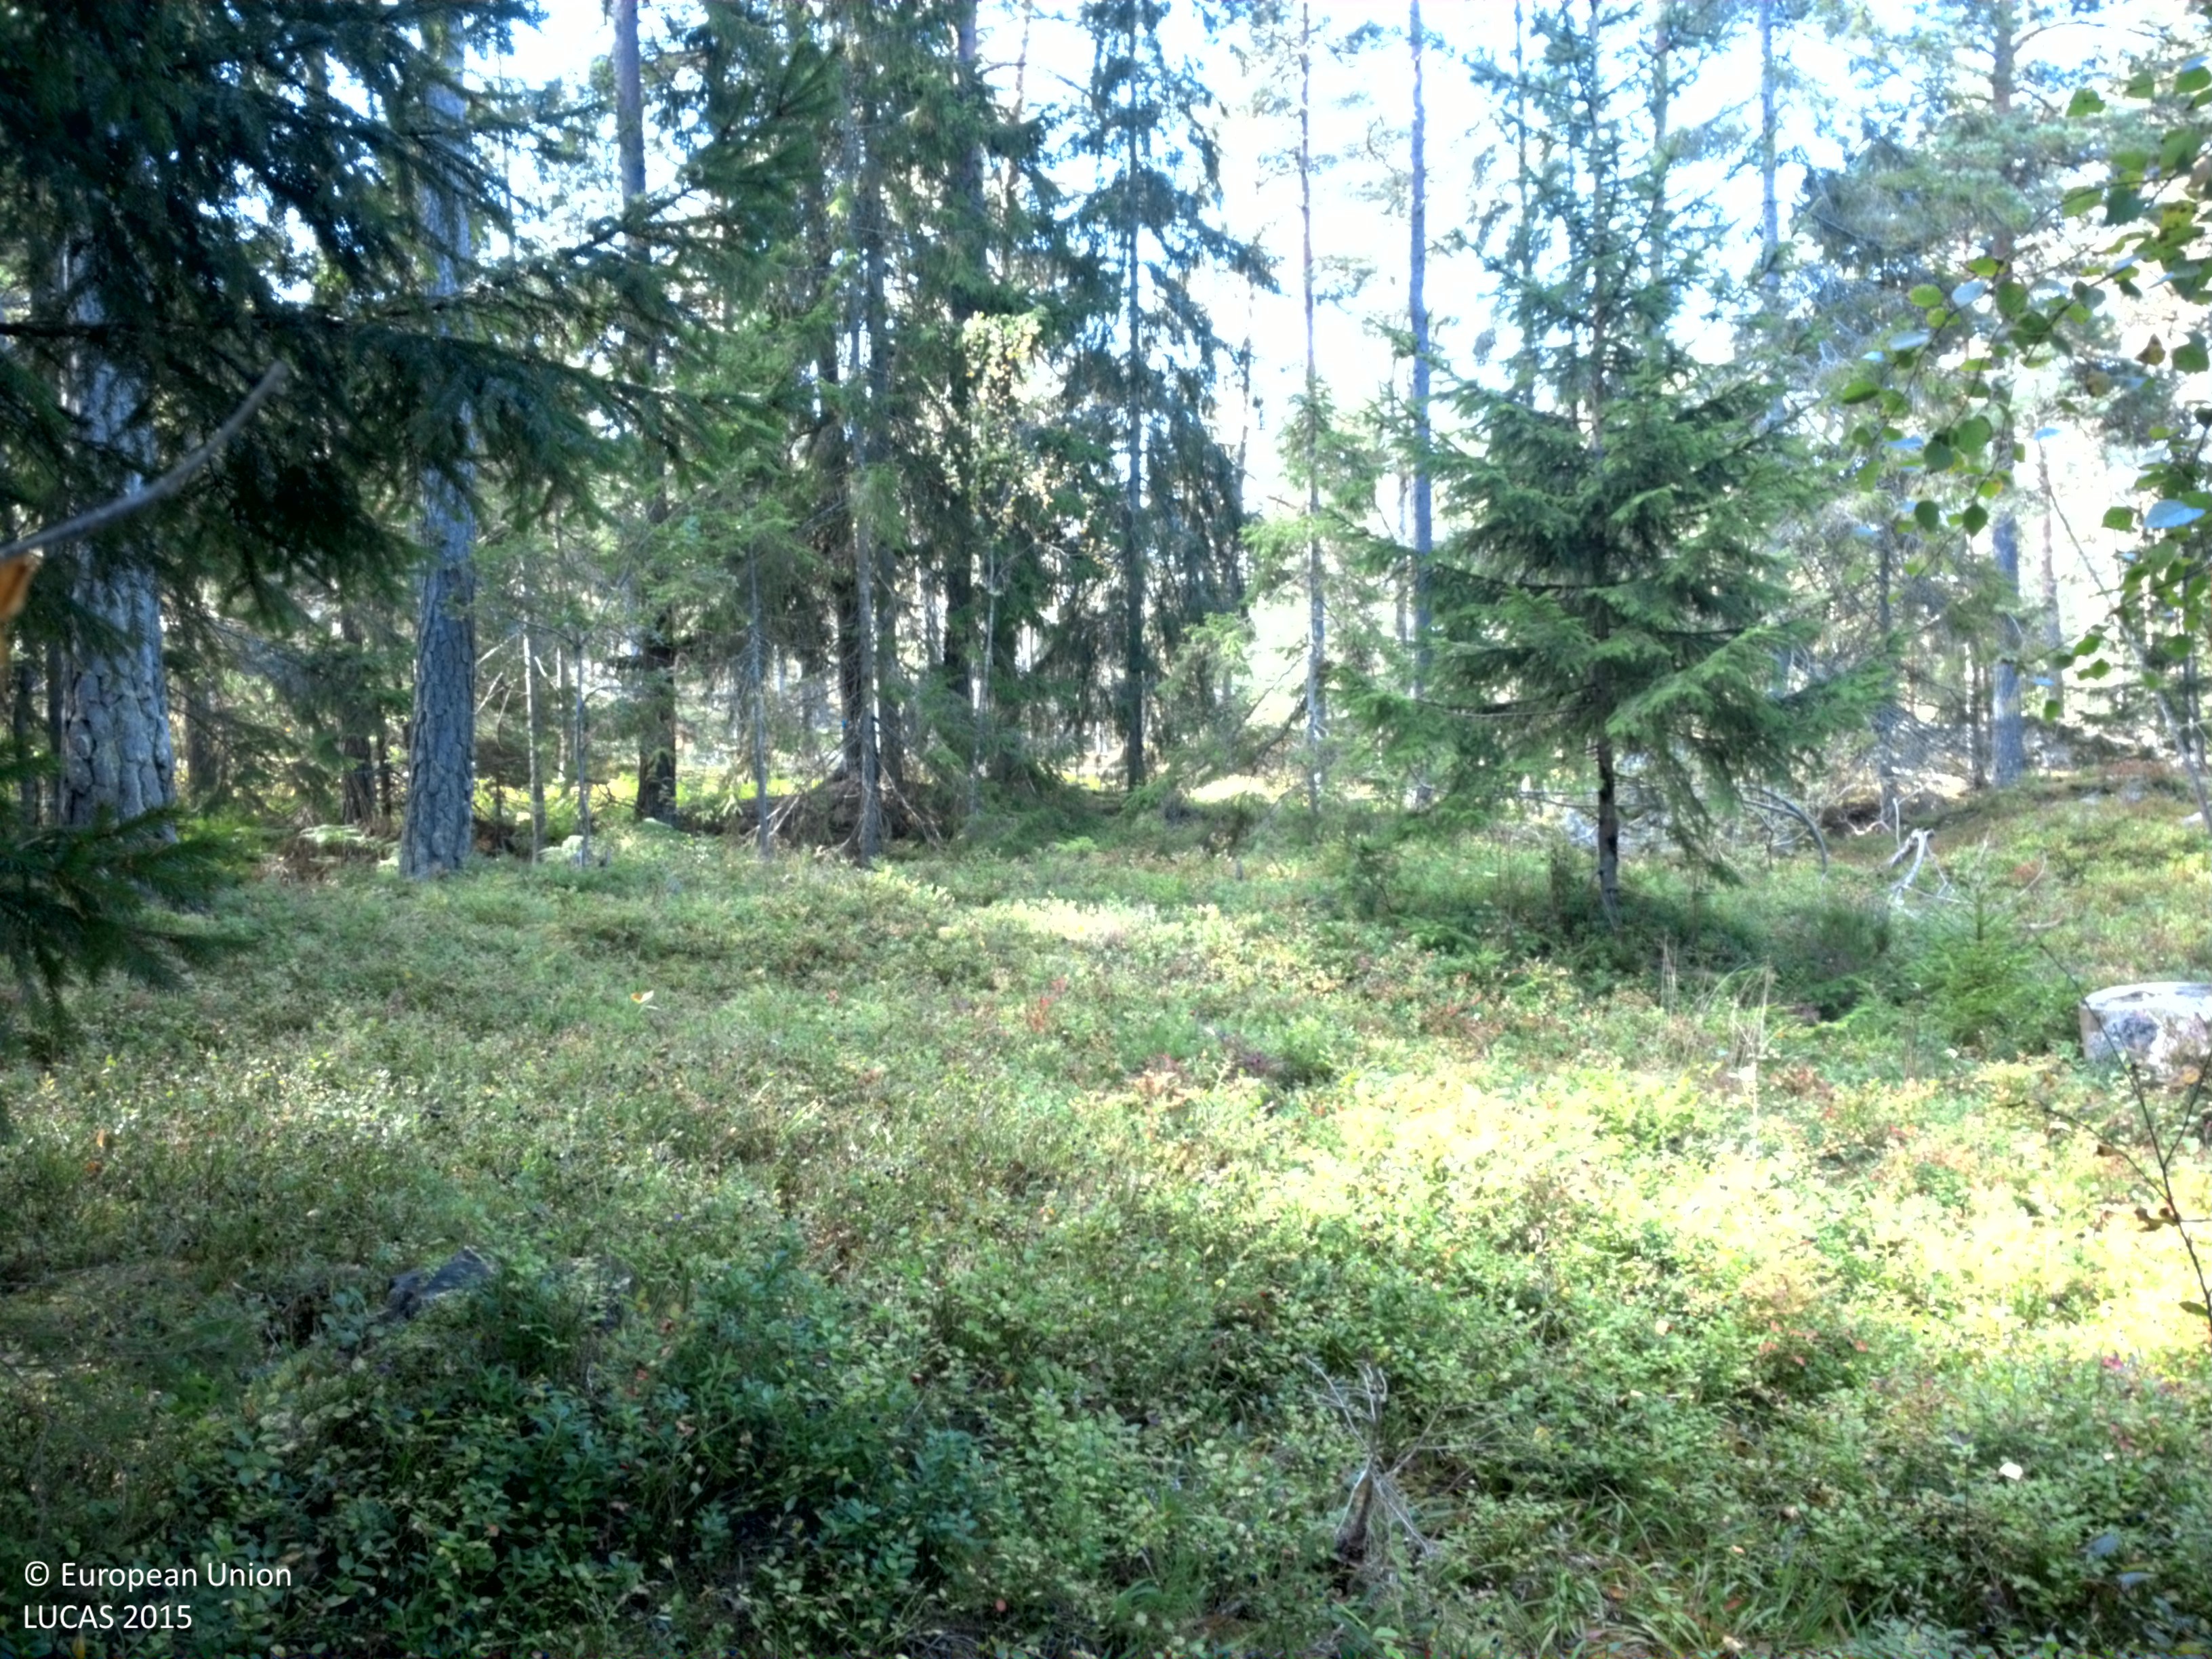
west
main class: Woodland
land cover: Spruce dominated coniferous woodland
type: boreal forest
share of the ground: 50 - 75 %
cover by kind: coniferous forest trees 60 %, broadleaved forest trees 15 %, shrubs 15 %, lichens and mosses 10 %
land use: Forestry
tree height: > 5 m
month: September
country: SE
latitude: 59.2754
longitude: 18.4414
